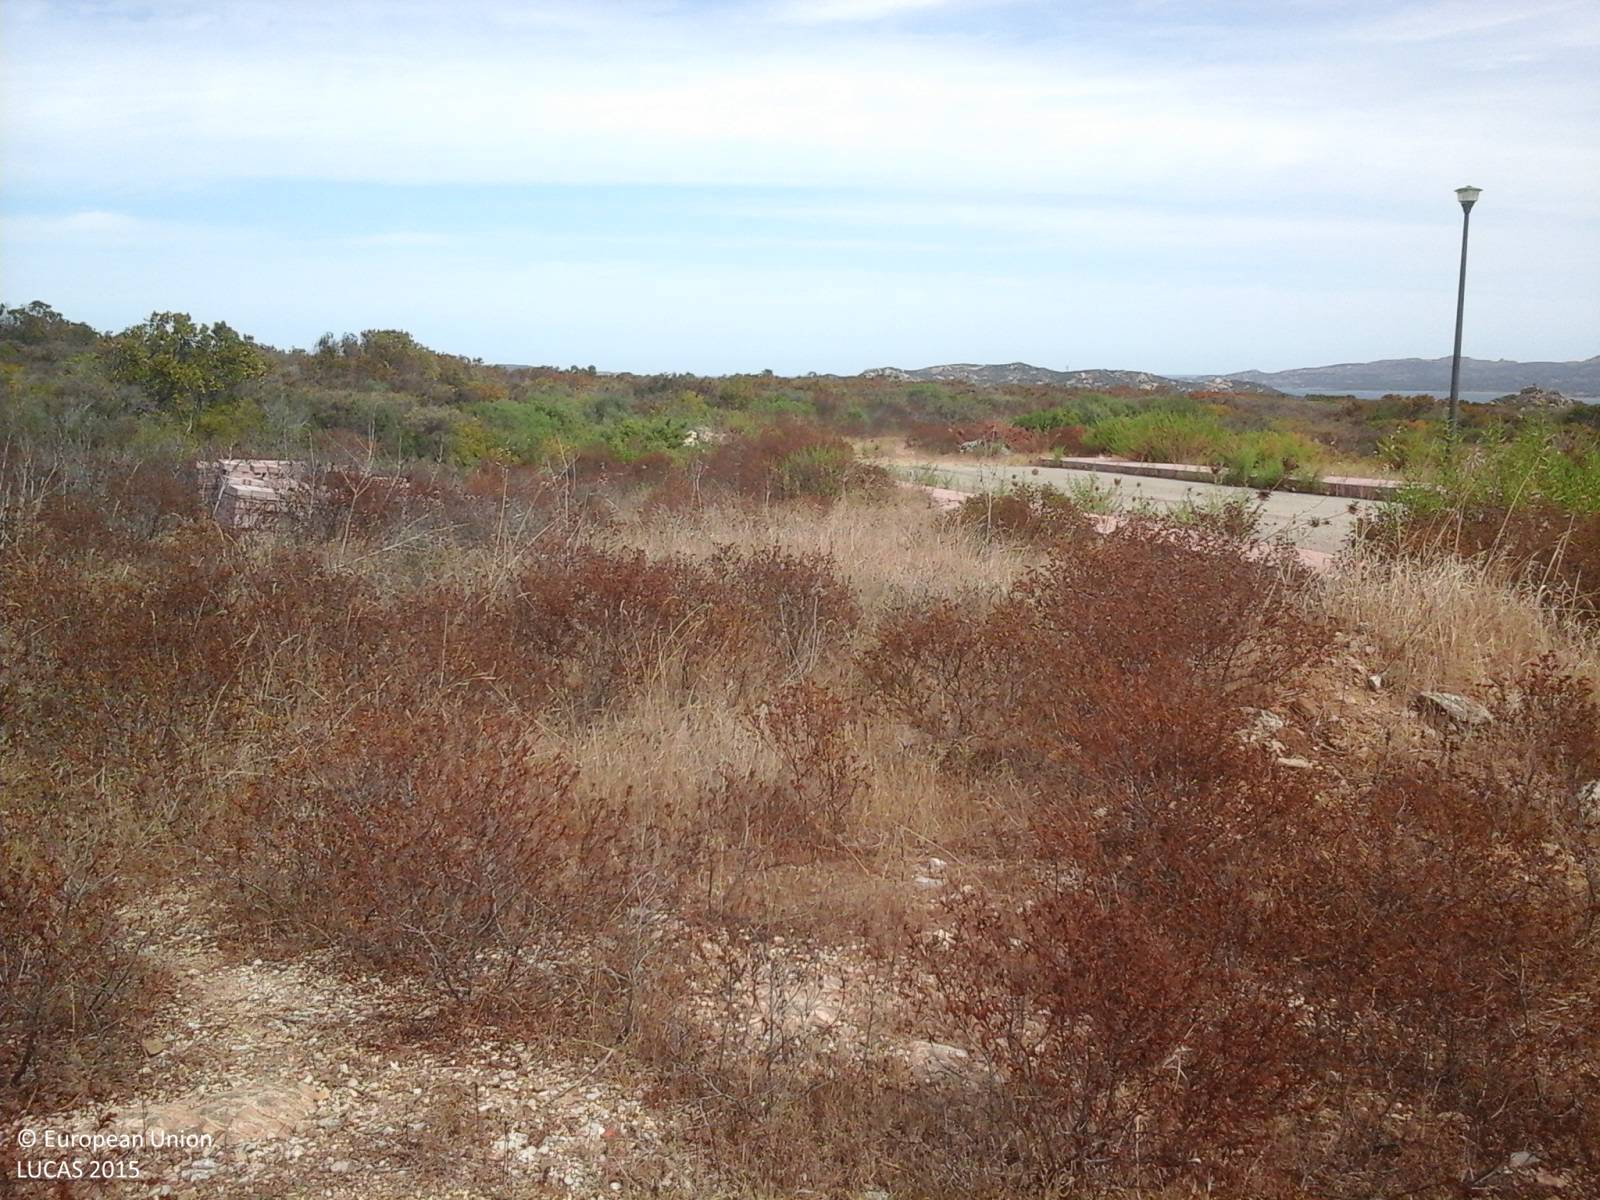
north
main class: Shrubland
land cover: Shrubland without tree cover
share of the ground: > 75 %
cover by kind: shrubs 95 %, unconsolidated bare surface 5 %
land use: Semi-natural and natural areas not in use
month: September
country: IT
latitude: 41.1702
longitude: 9.3948
